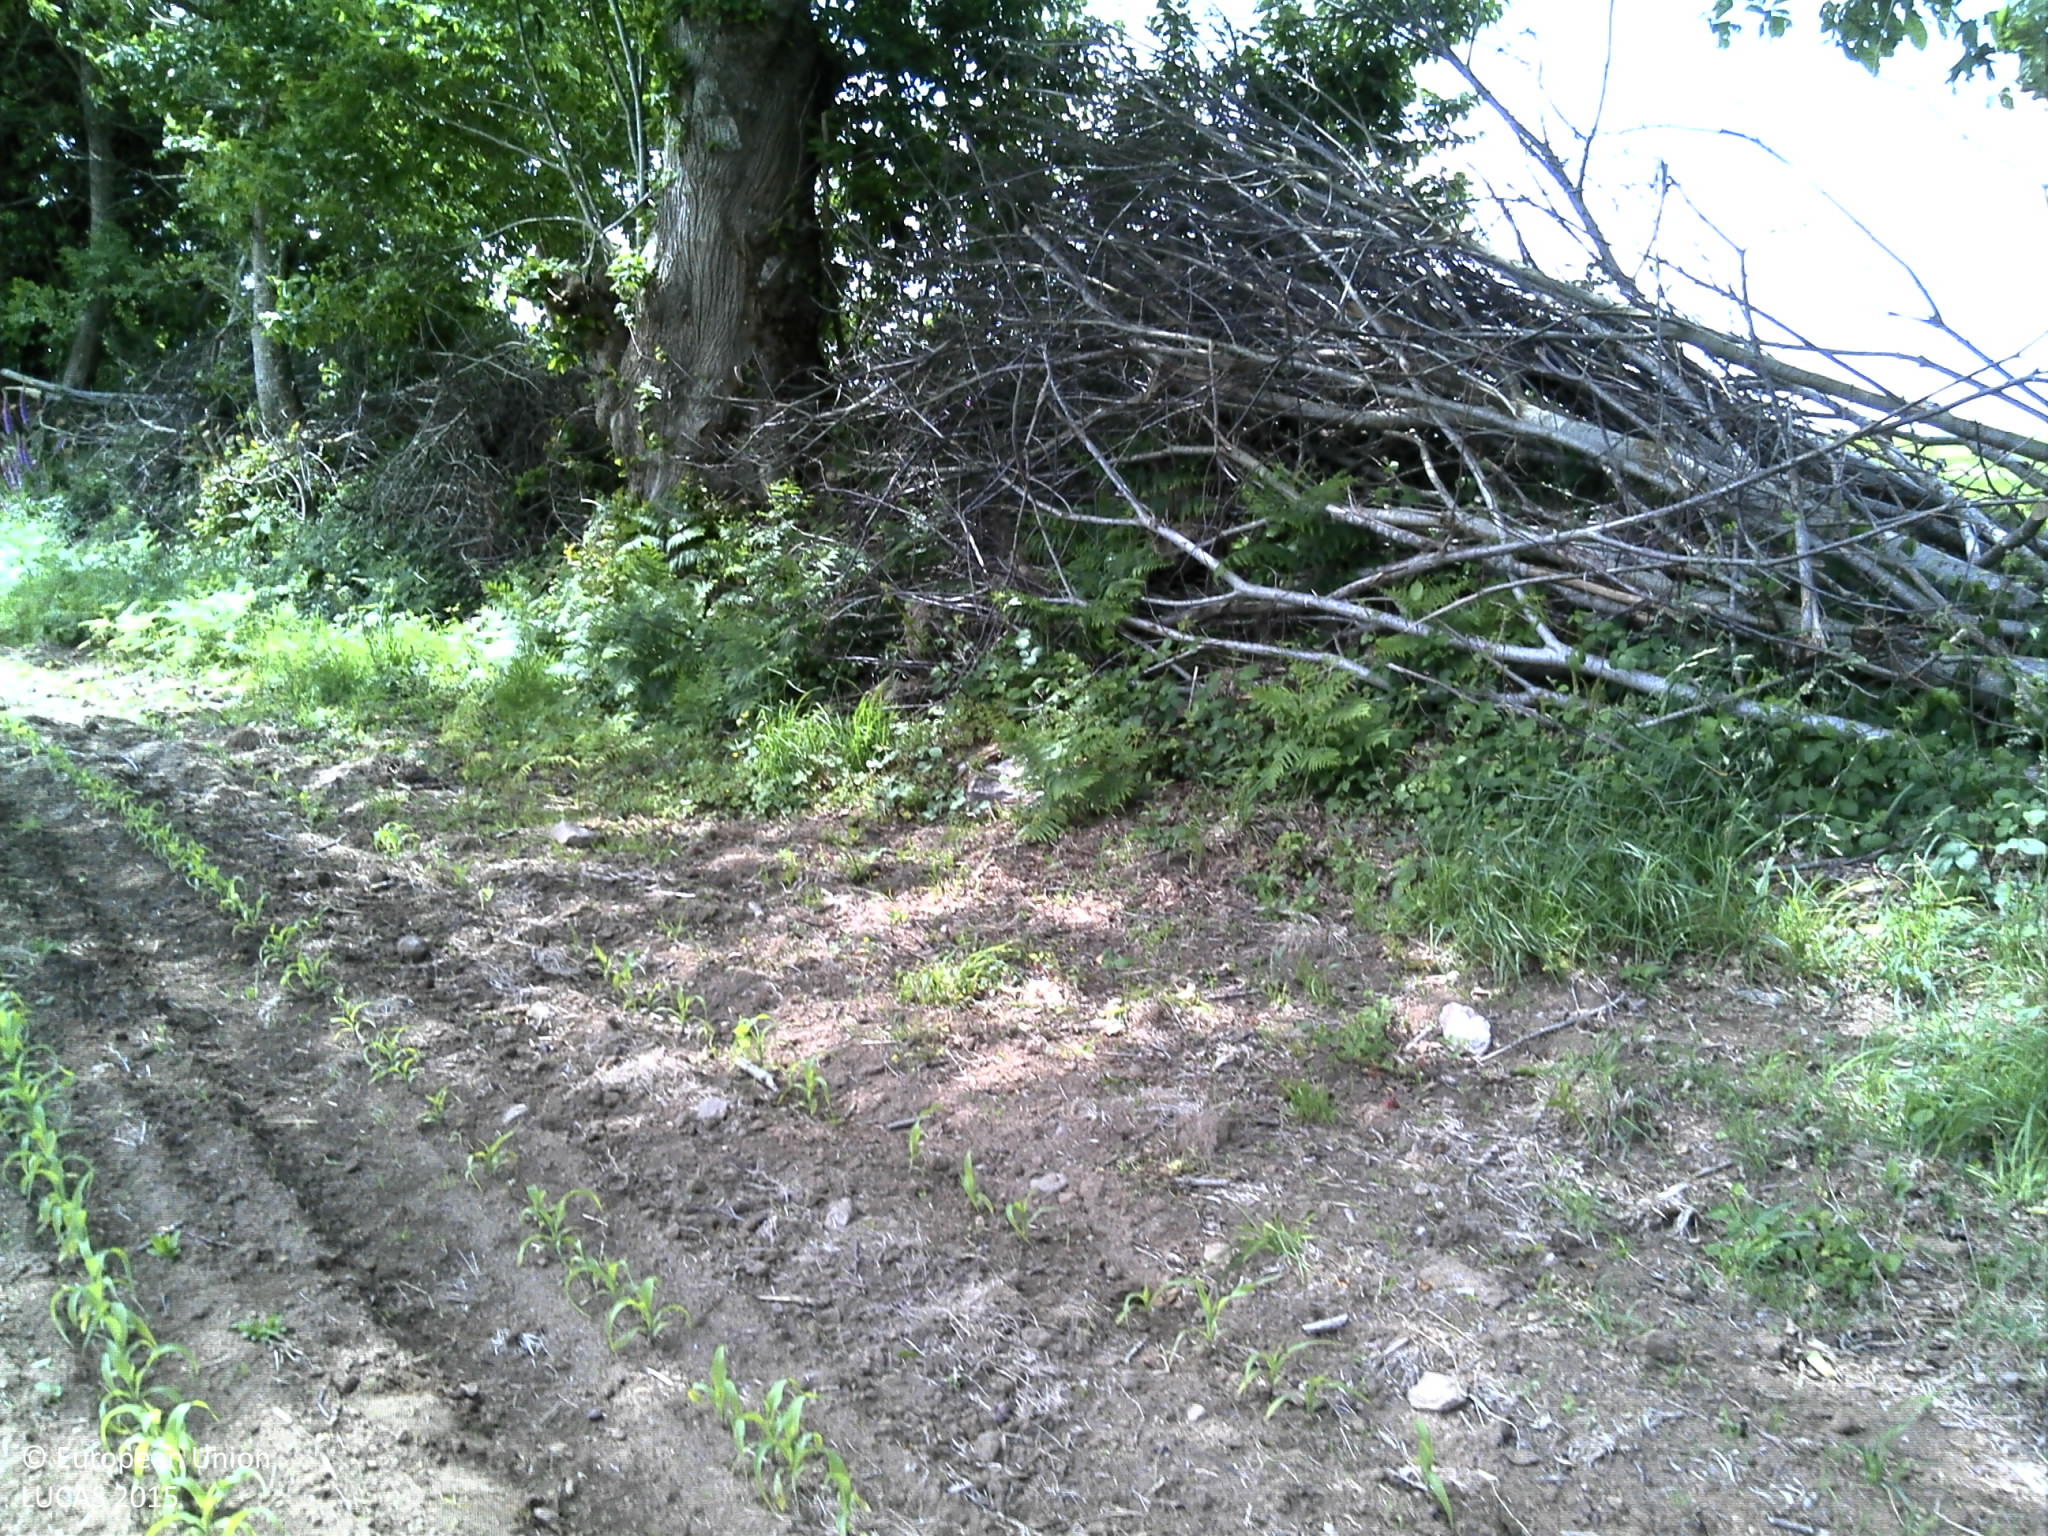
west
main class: Cropland
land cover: Maize
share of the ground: 10 - 25 %
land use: Agriculture (excluding fallow land and kitchen gardens)
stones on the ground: 10 - 25 %
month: June
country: FR
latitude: 47.9608
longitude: -3.5911
